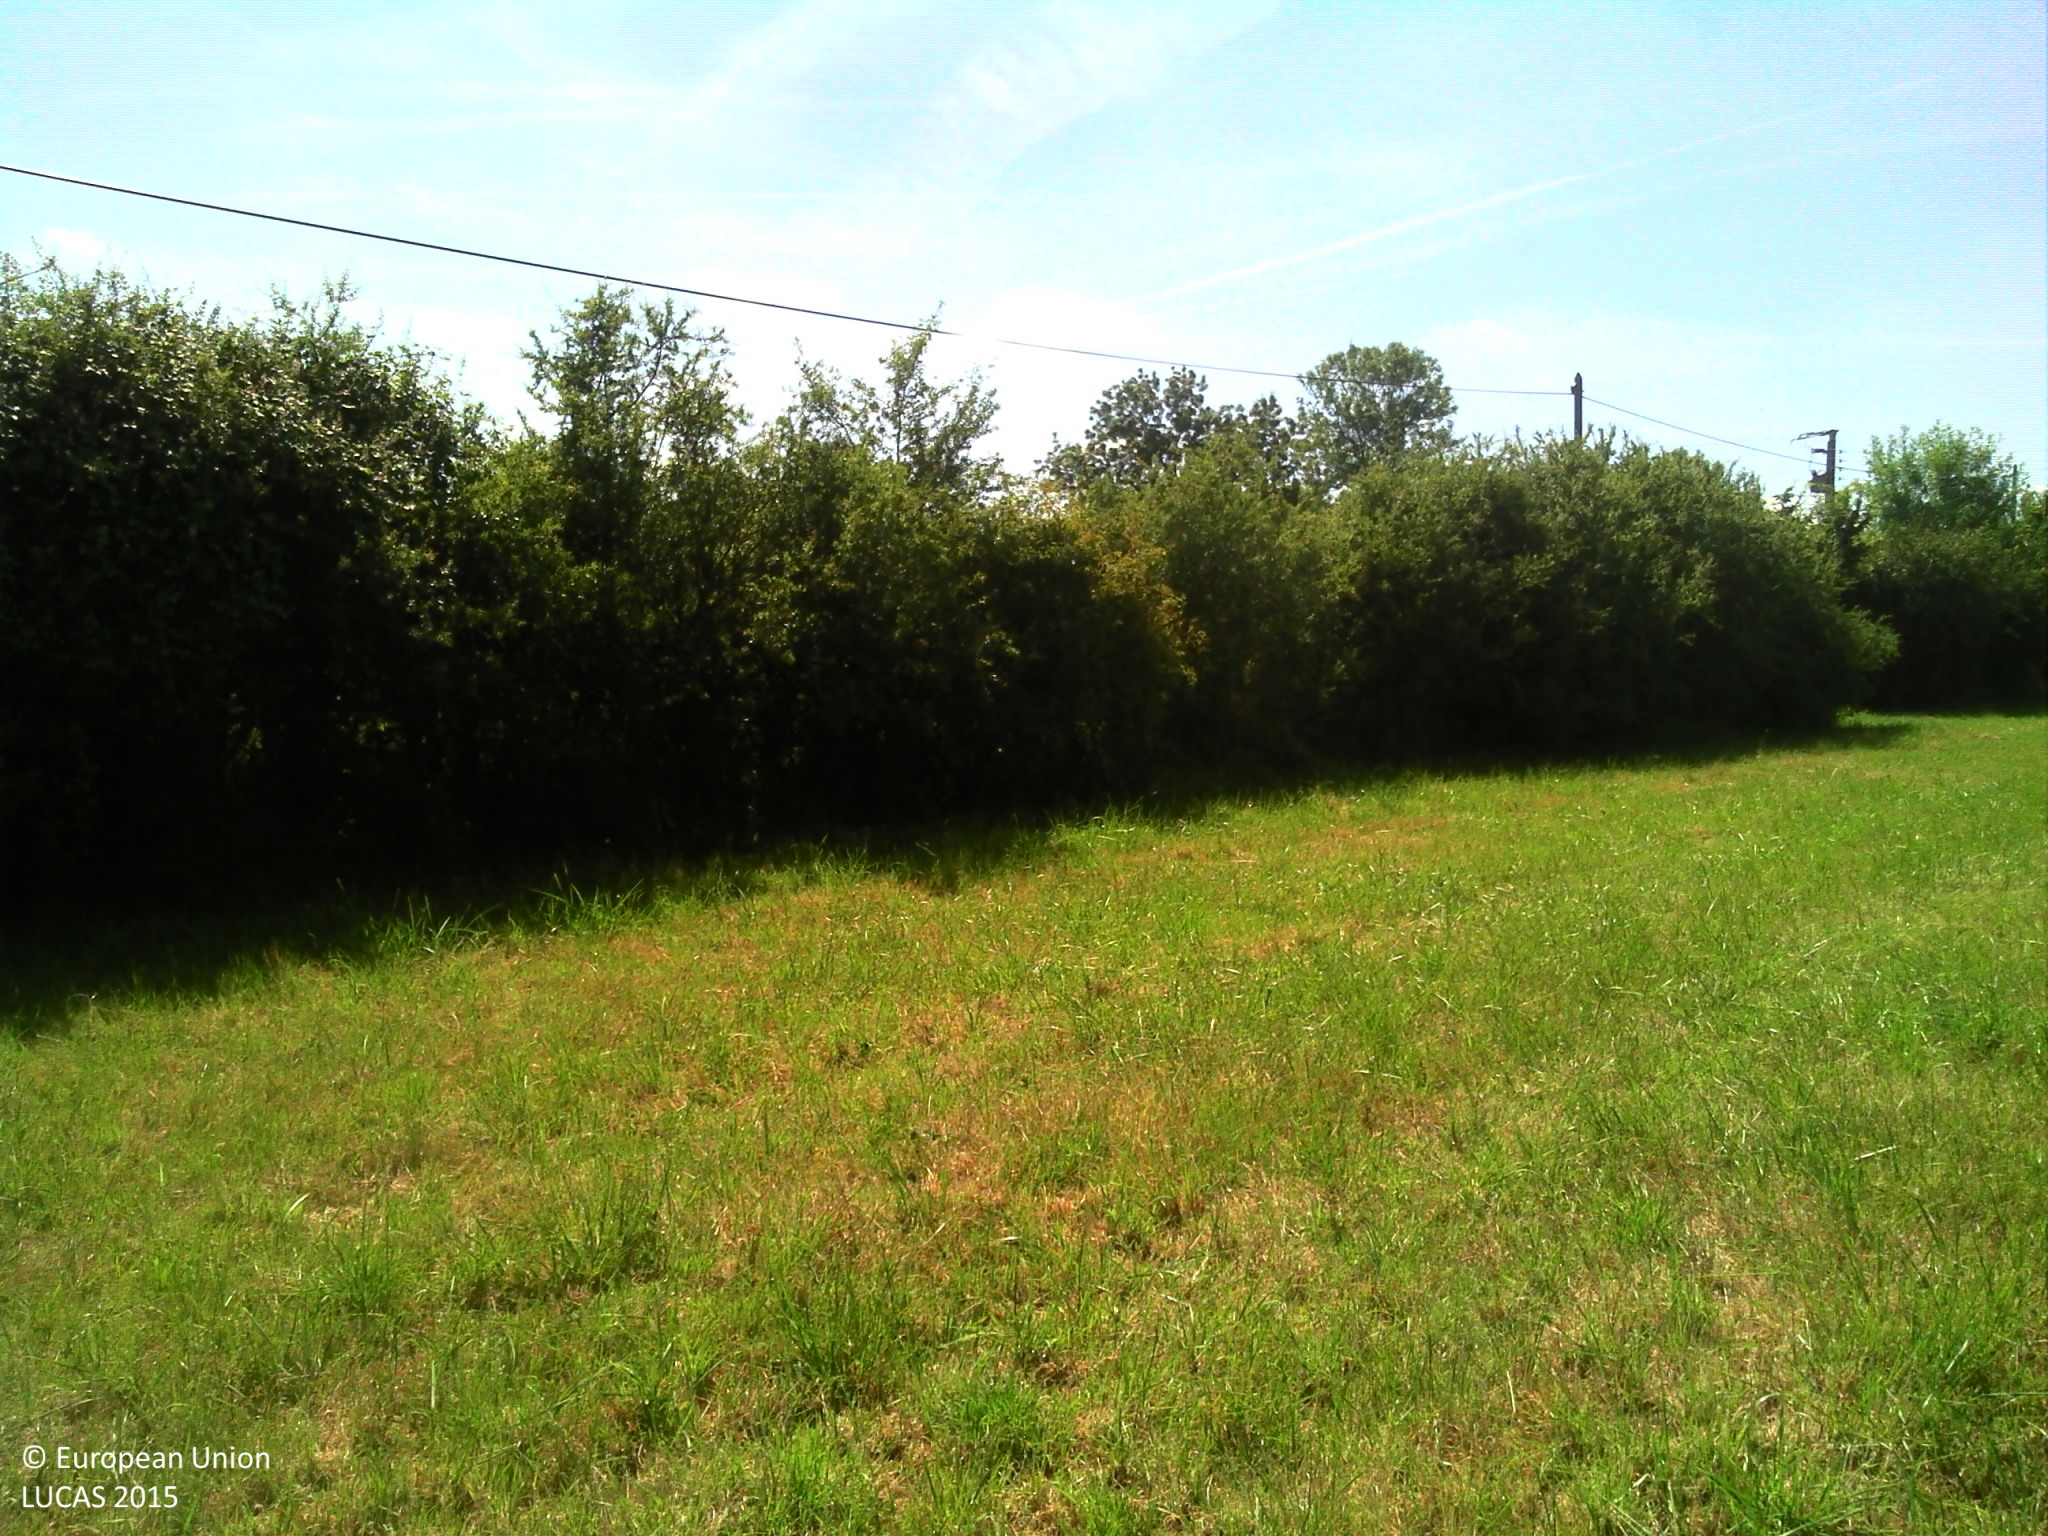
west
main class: Grassland
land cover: Grassland without tree/shrub cover
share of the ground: > 75 %
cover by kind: herbaceous plants 100 %
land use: Agriculture (excluding fallow land and kitchen gardens)
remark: Harvested field
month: June
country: FR
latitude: 47.5938
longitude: 0.2814
